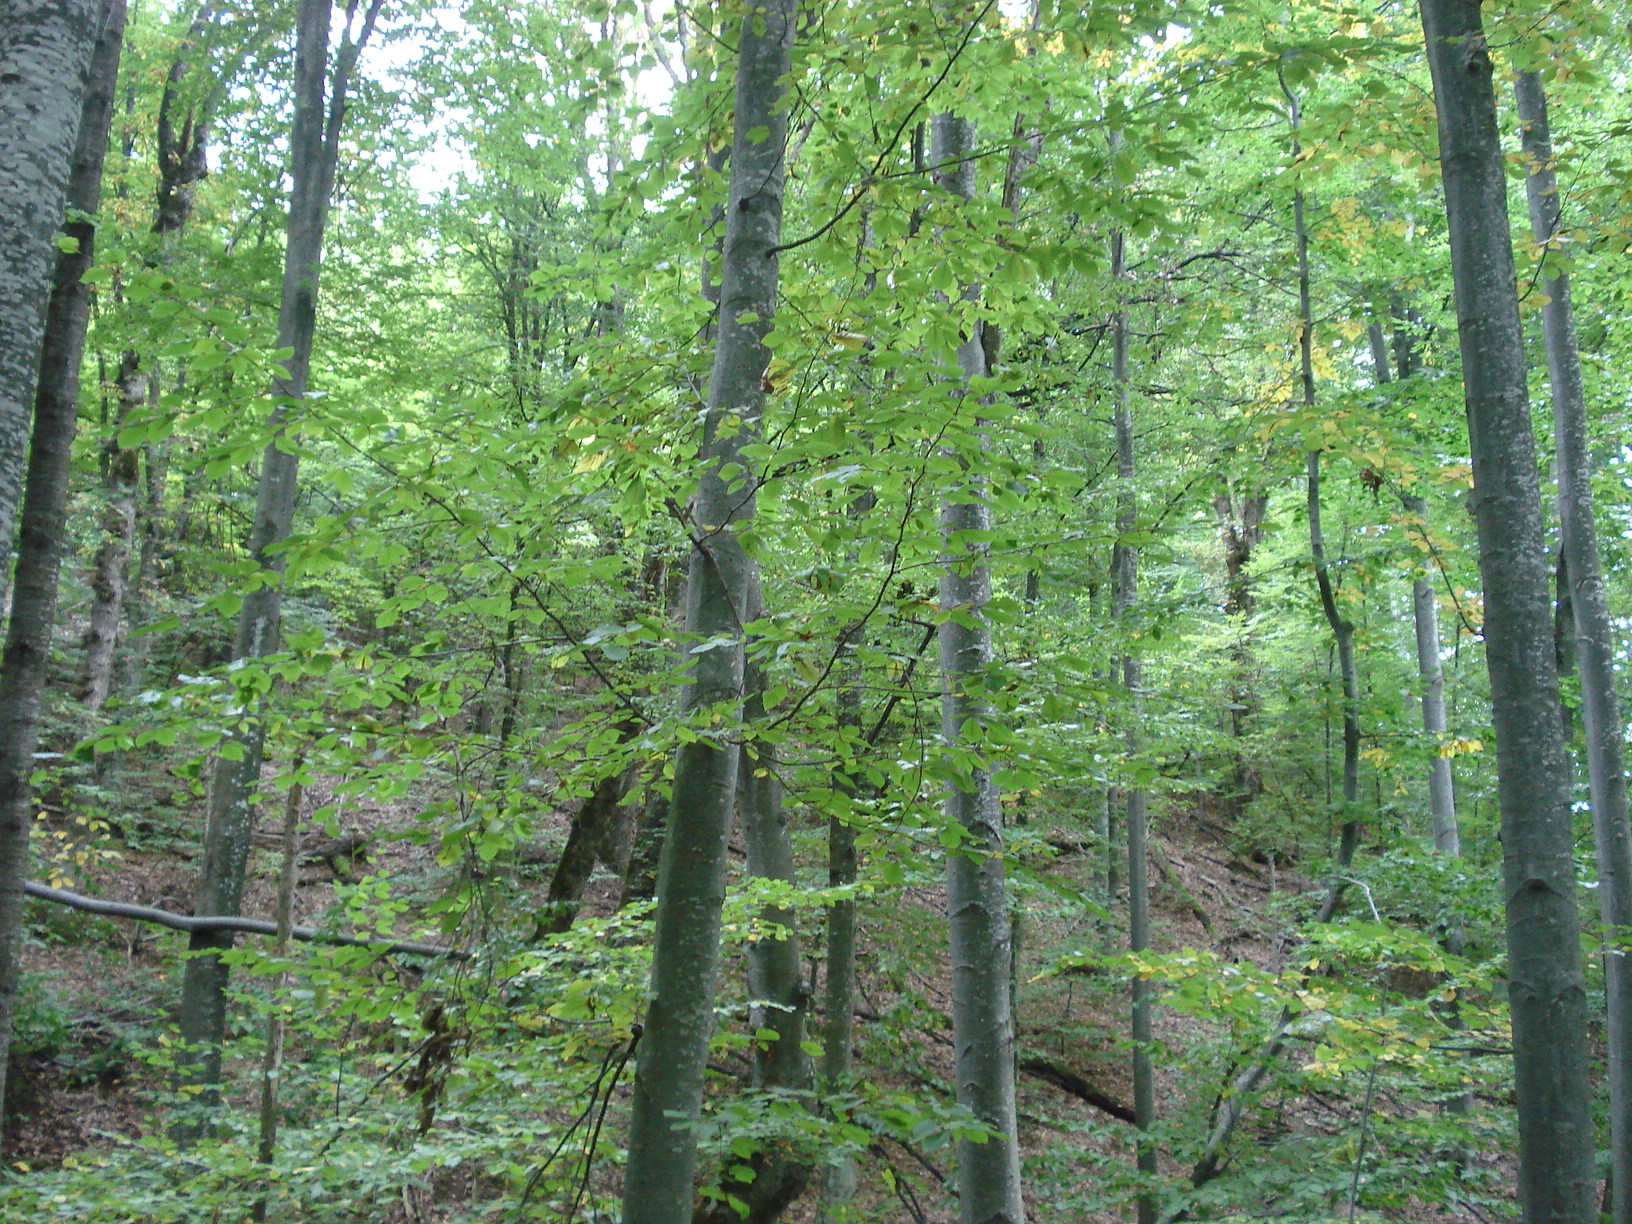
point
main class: Woodland
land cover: Broadleaved woodland
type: beech forest
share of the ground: 50 - 75 %
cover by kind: broadleaved forest trees 70 %, unconsolidated bare surface 25 %, herbaceous plants 5 %
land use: Forestry
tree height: > 5 m
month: October
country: BG
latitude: 42.8393
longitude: 25.9025
